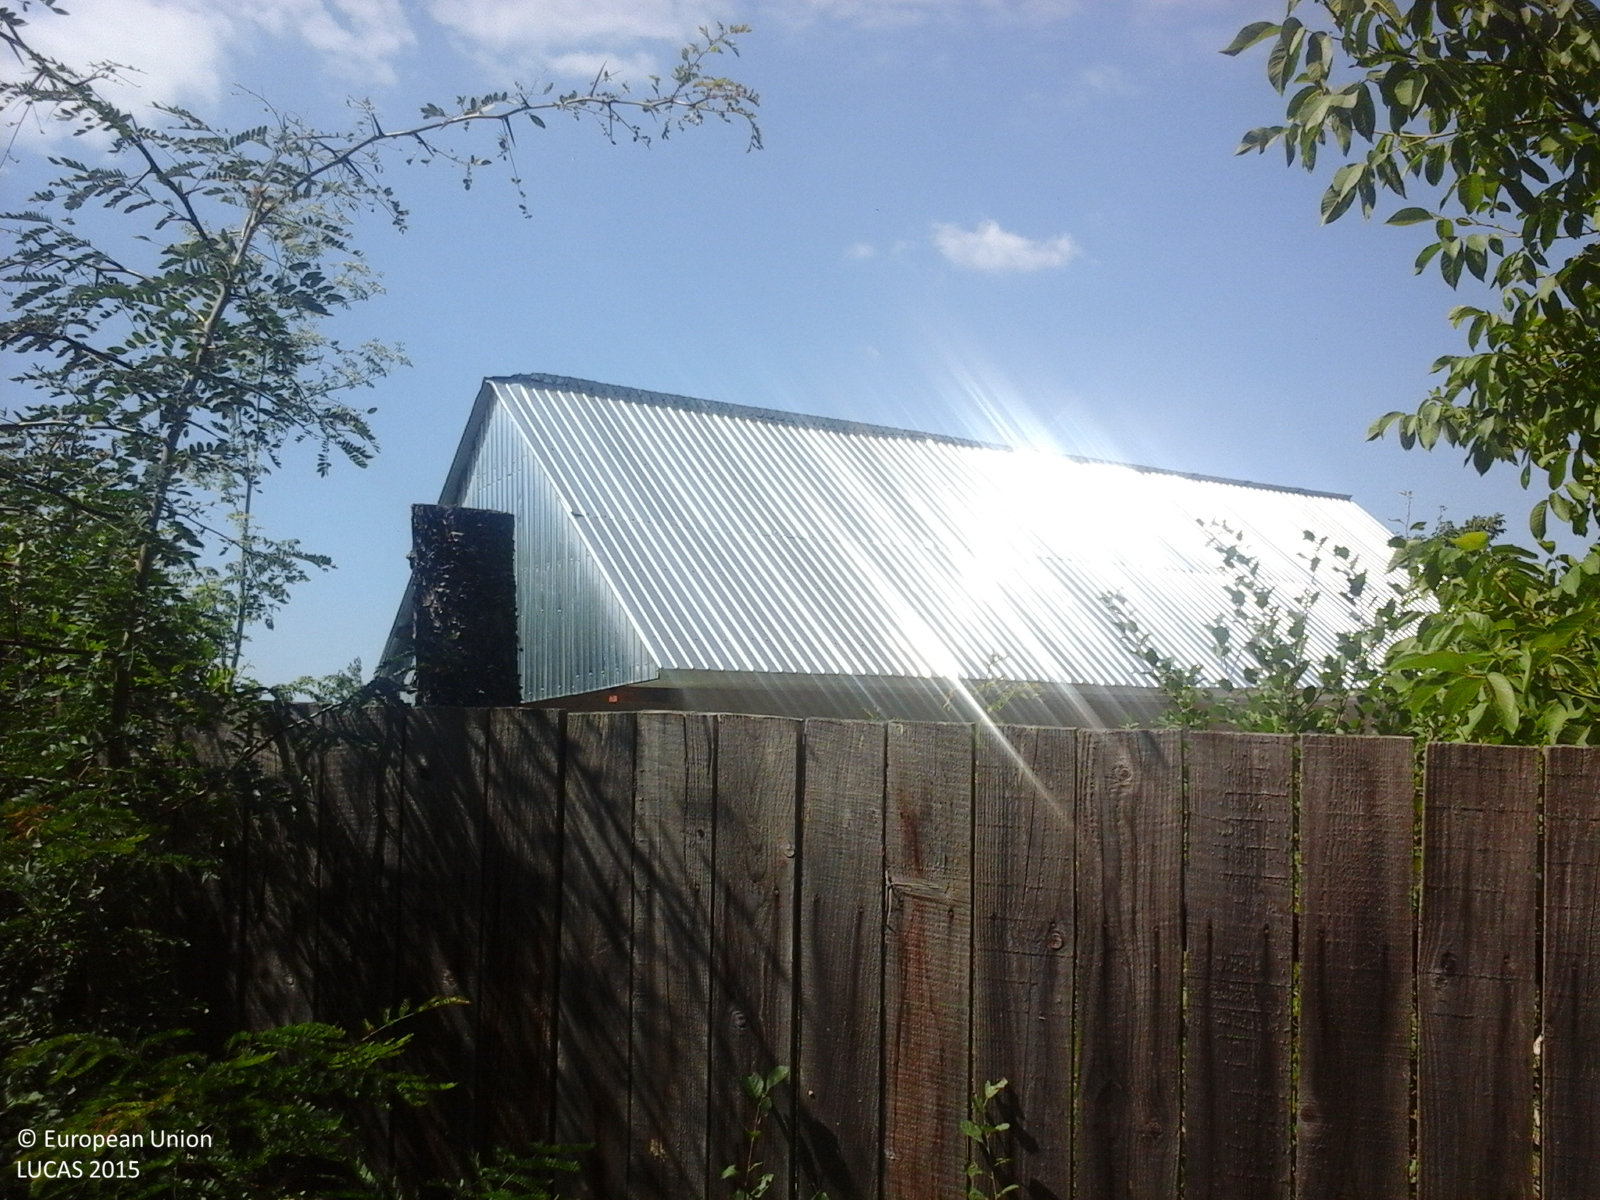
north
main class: Shrubland
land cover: Shrubland with sparse tree cover
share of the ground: > 75 %
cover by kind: shrubs 95 %, broadleaved forest trees 5 %
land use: Semi-natural and natural areas not in use
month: June
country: RO
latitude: 46.7074
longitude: 27.3337
